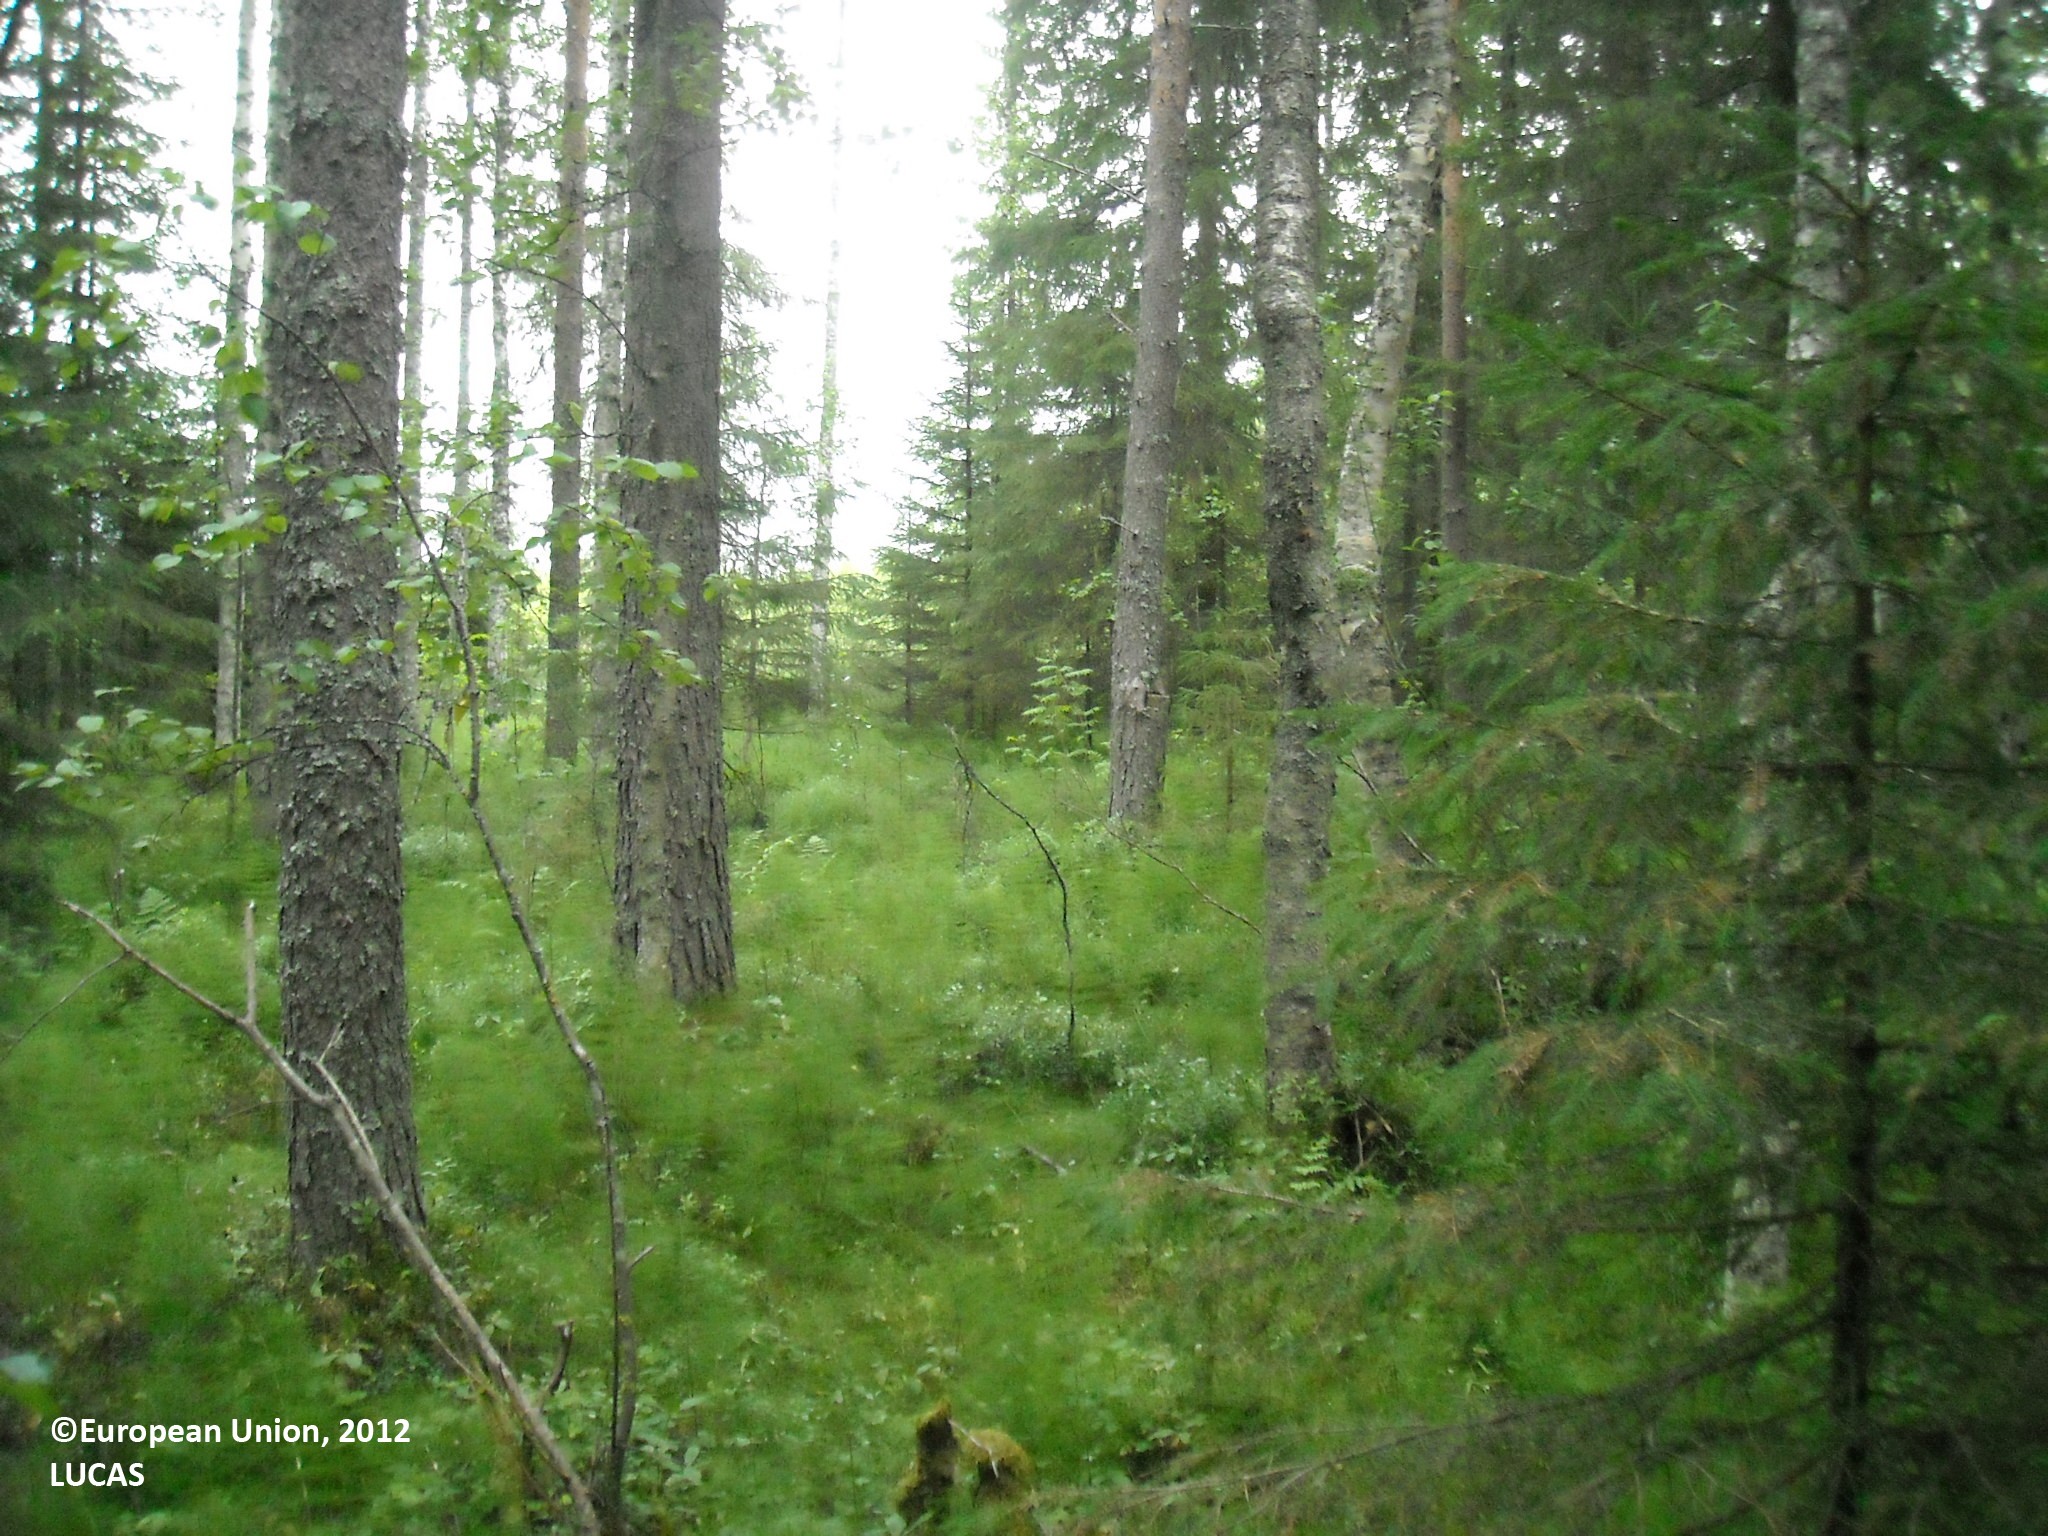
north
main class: Woodland
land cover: Other mixed woodland
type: boreal forest
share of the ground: > 75 %
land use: Forestry
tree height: > 5 m
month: July
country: FI
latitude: 64.8785
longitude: 26.6867
